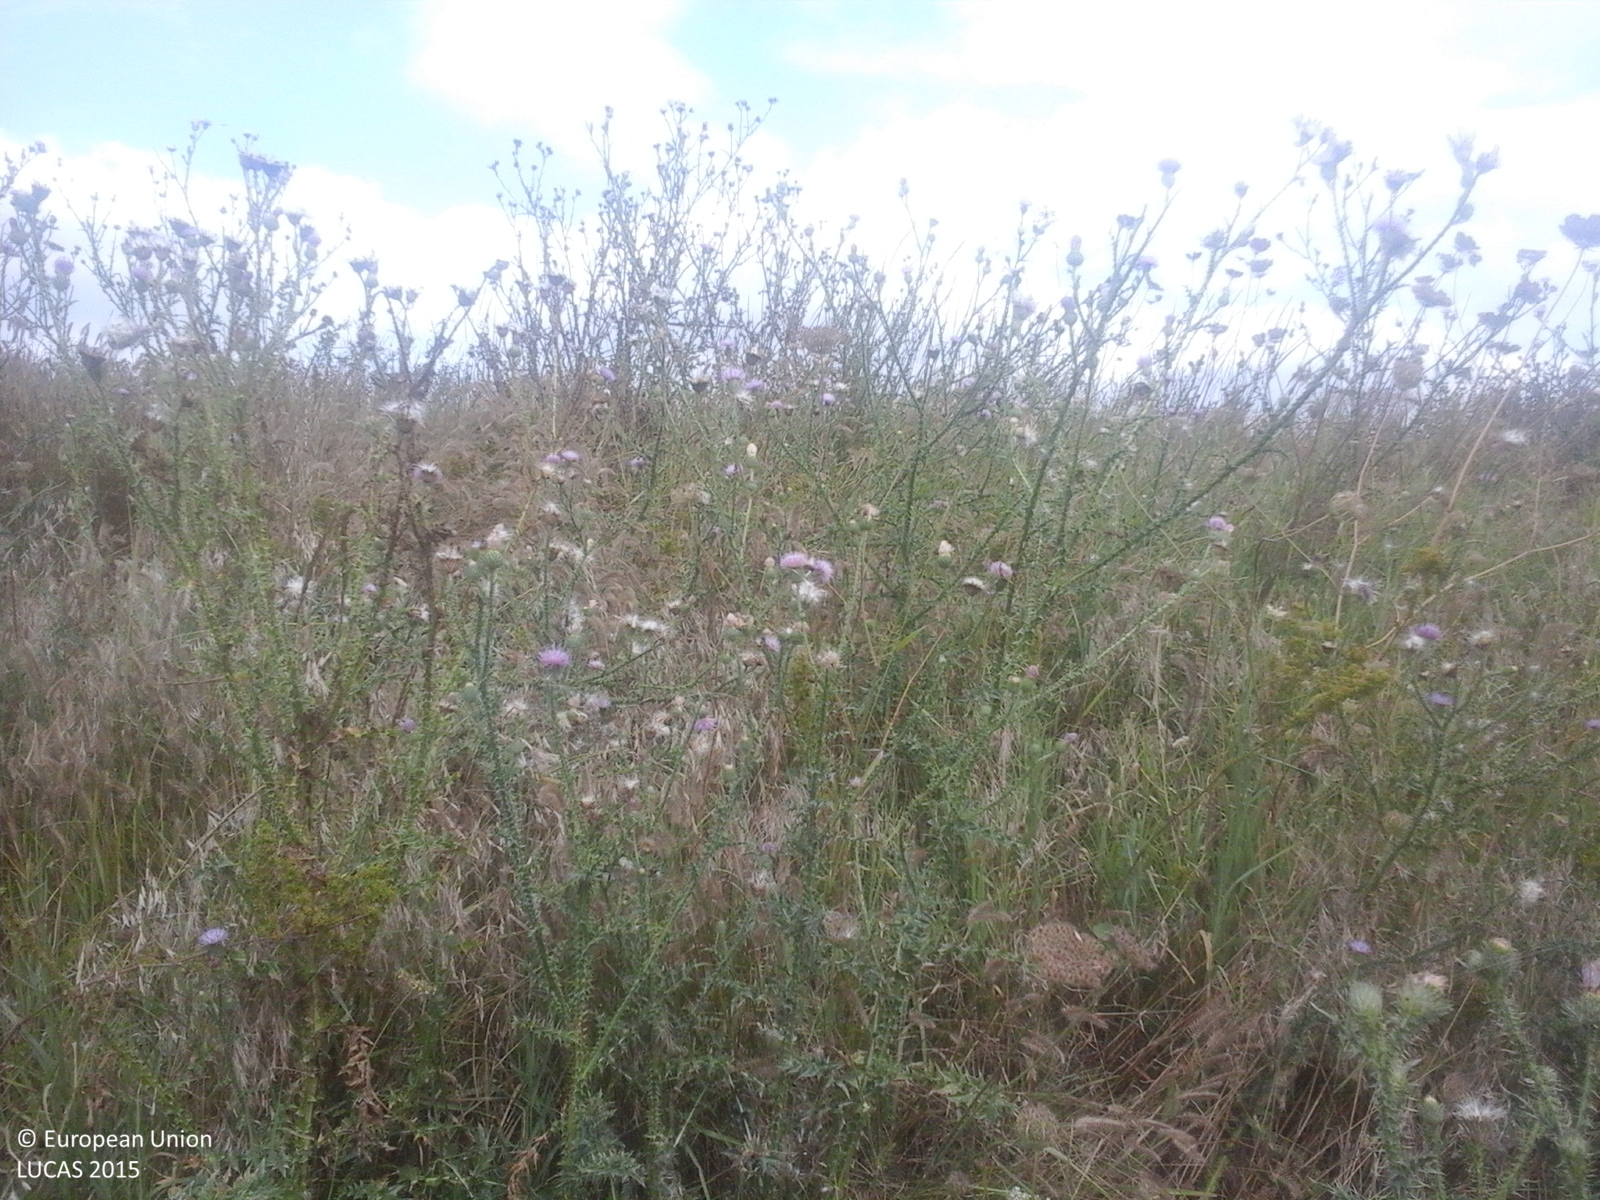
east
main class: Cropland
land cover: Maize
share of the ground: > 75 %
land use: Agriculture (excluding fallow land and kitchen gardens)
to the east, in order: Maize; Shruby margins; Durum wheat; Shruby margins; Common wheat; Shruby margins; Common wheat; Grass margins; Tracks; Grass margins; Durum wheat
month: August
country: RO
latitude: 44.6289
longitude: 28.2813
